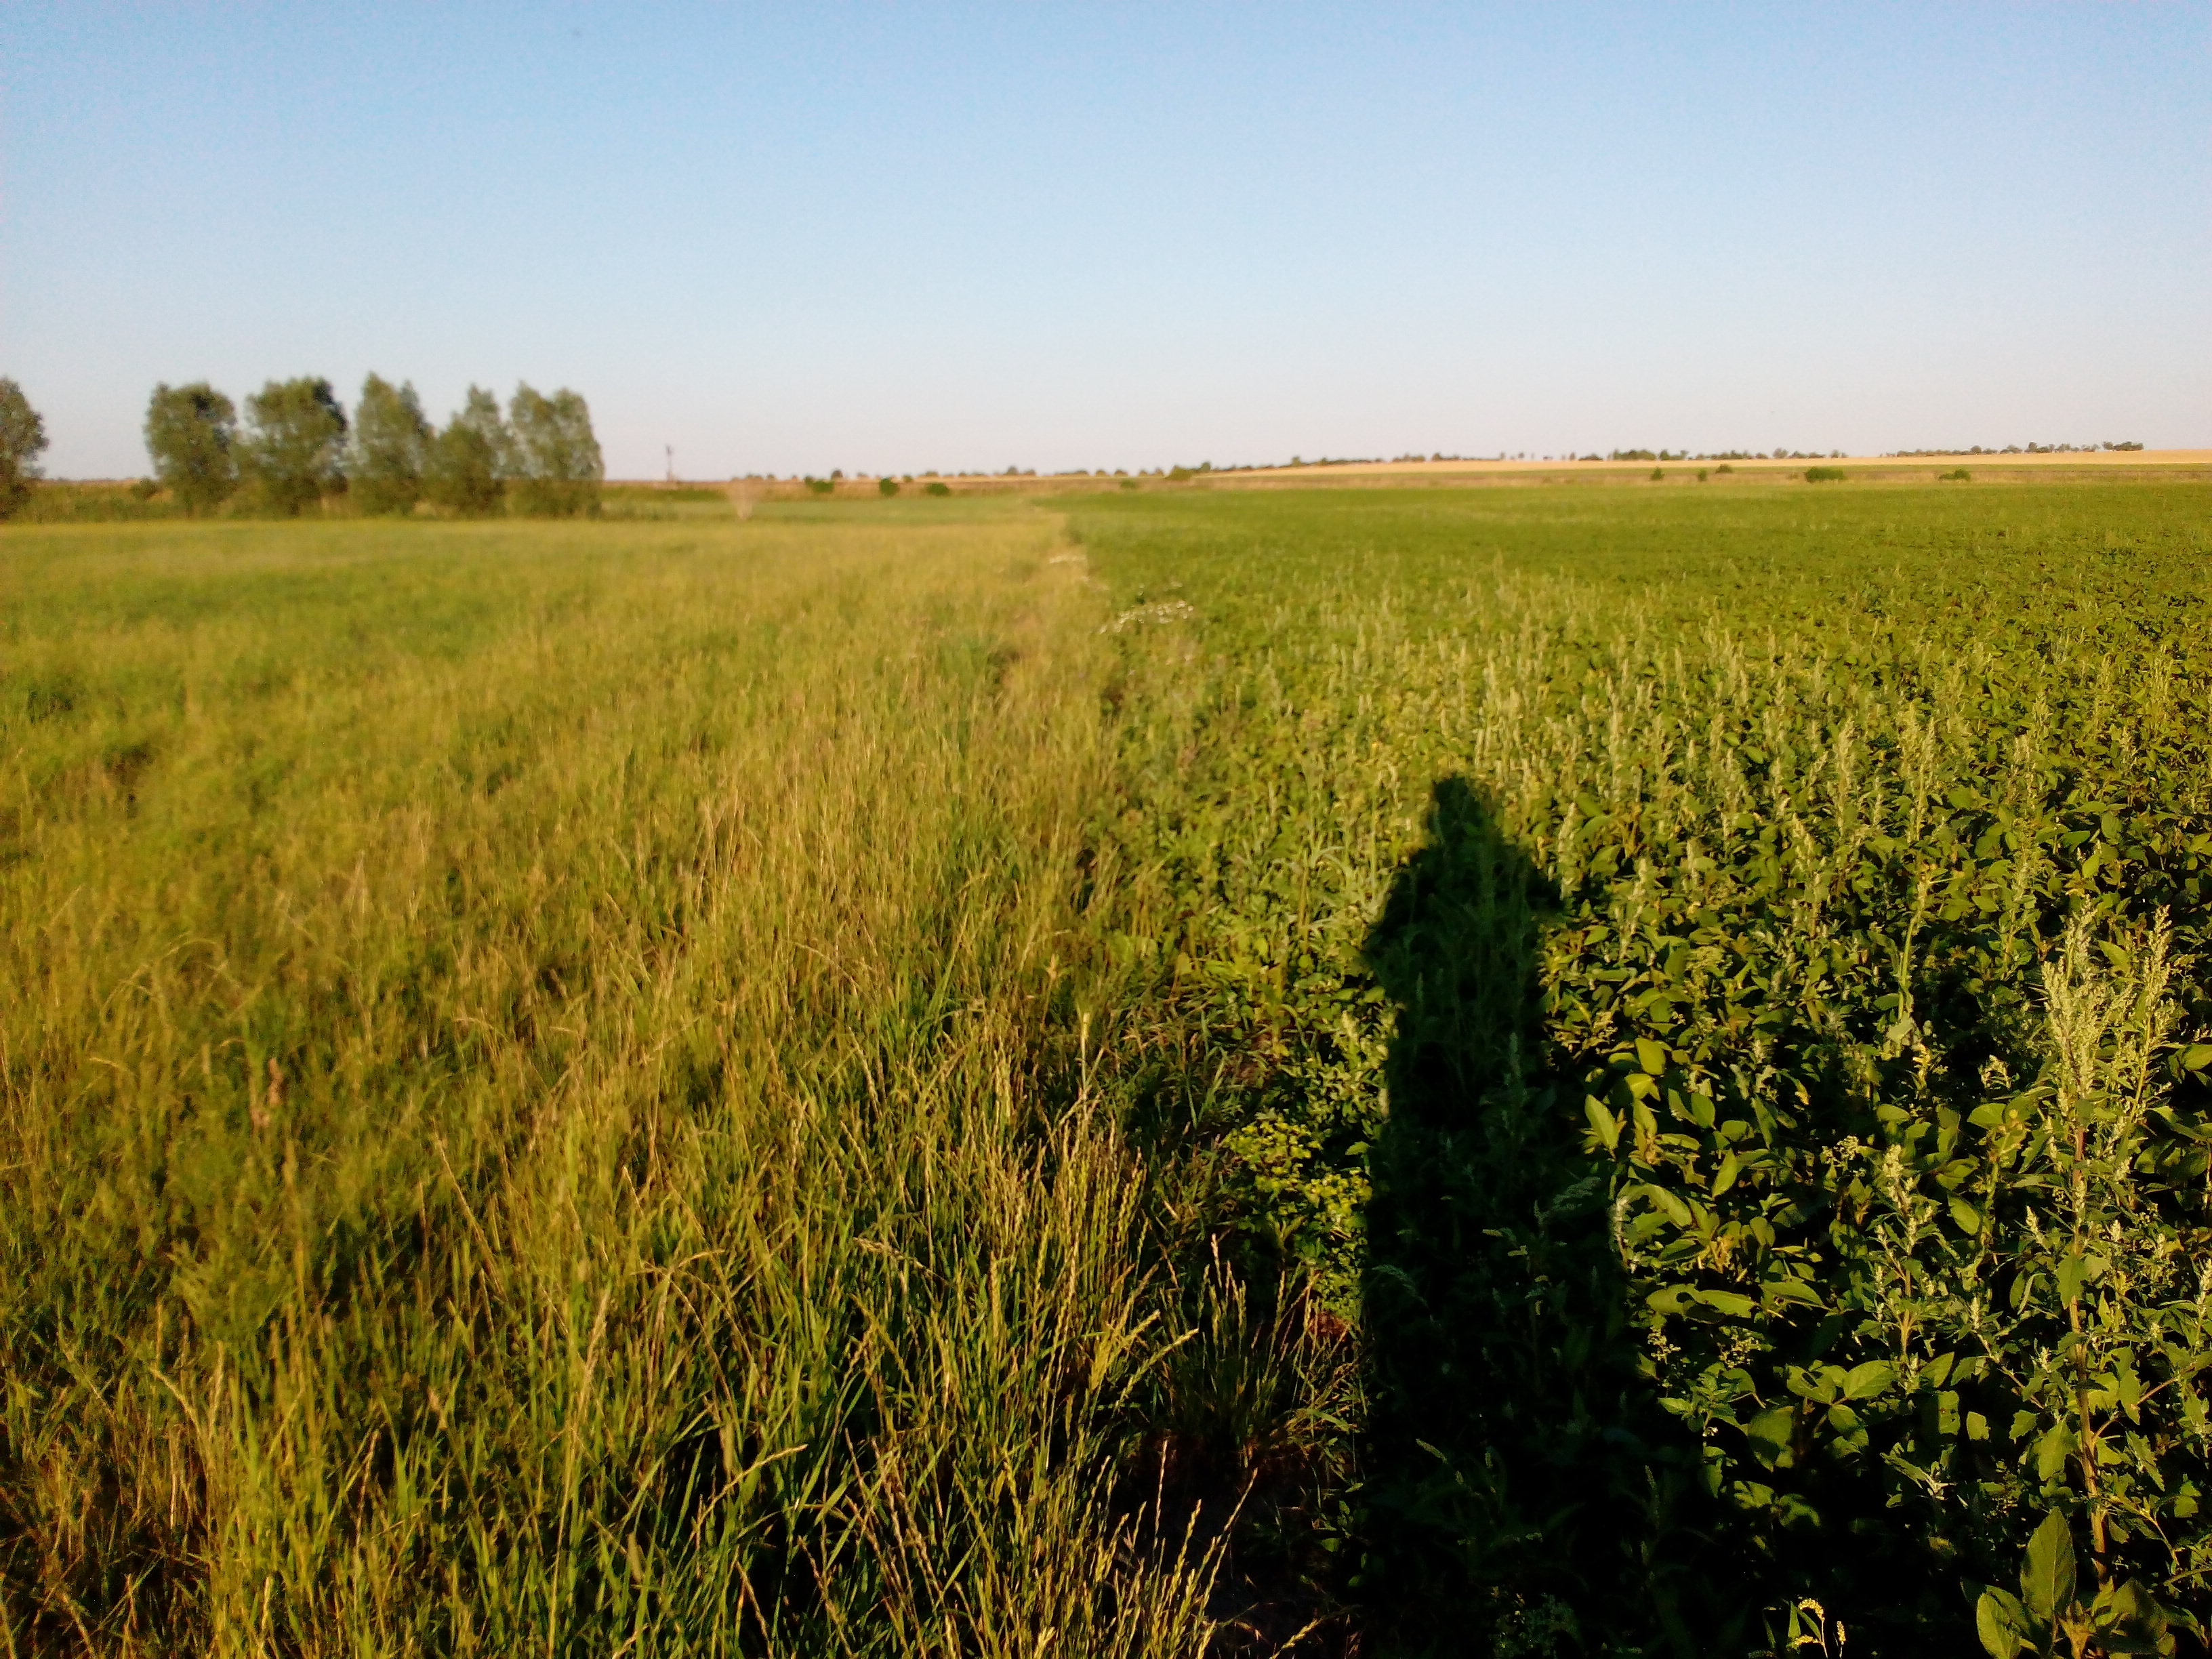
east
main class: Grassland
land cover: Grassland without tree/shrub cover
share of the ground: > 75 %
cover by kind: herbaceous plants 100 %
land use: Agriculture (excluding fallow land and kitchen gardens)
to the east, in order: Grassland without tree/shrub cover; Ditches and canals; Grassland without tree/shrub cover
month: July
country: DE
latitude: 51.1152
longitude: 10.9568
